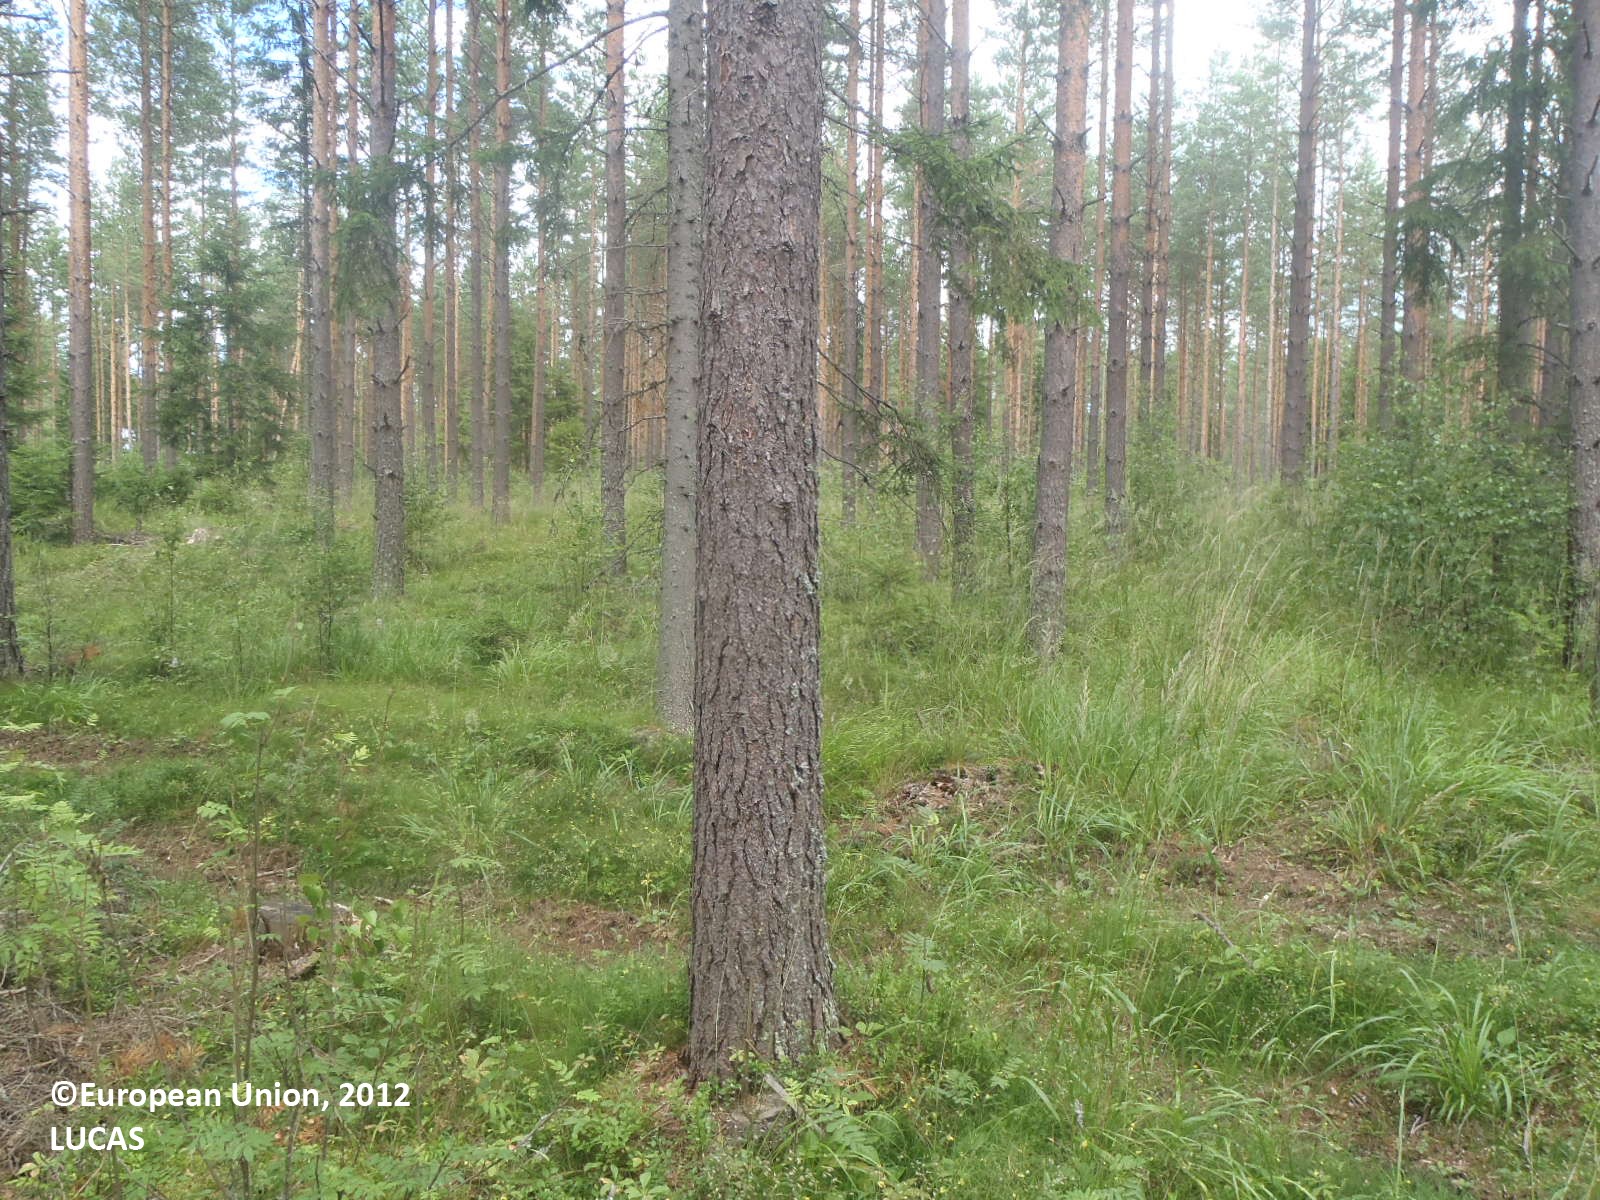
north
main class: Woodland
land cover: Other coniferous woodland
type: boreal forest
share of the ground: 25 - 50 %
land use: Forestry
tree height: > 5 m
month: July
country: FI
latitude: 61.1885
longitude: 21.9064
